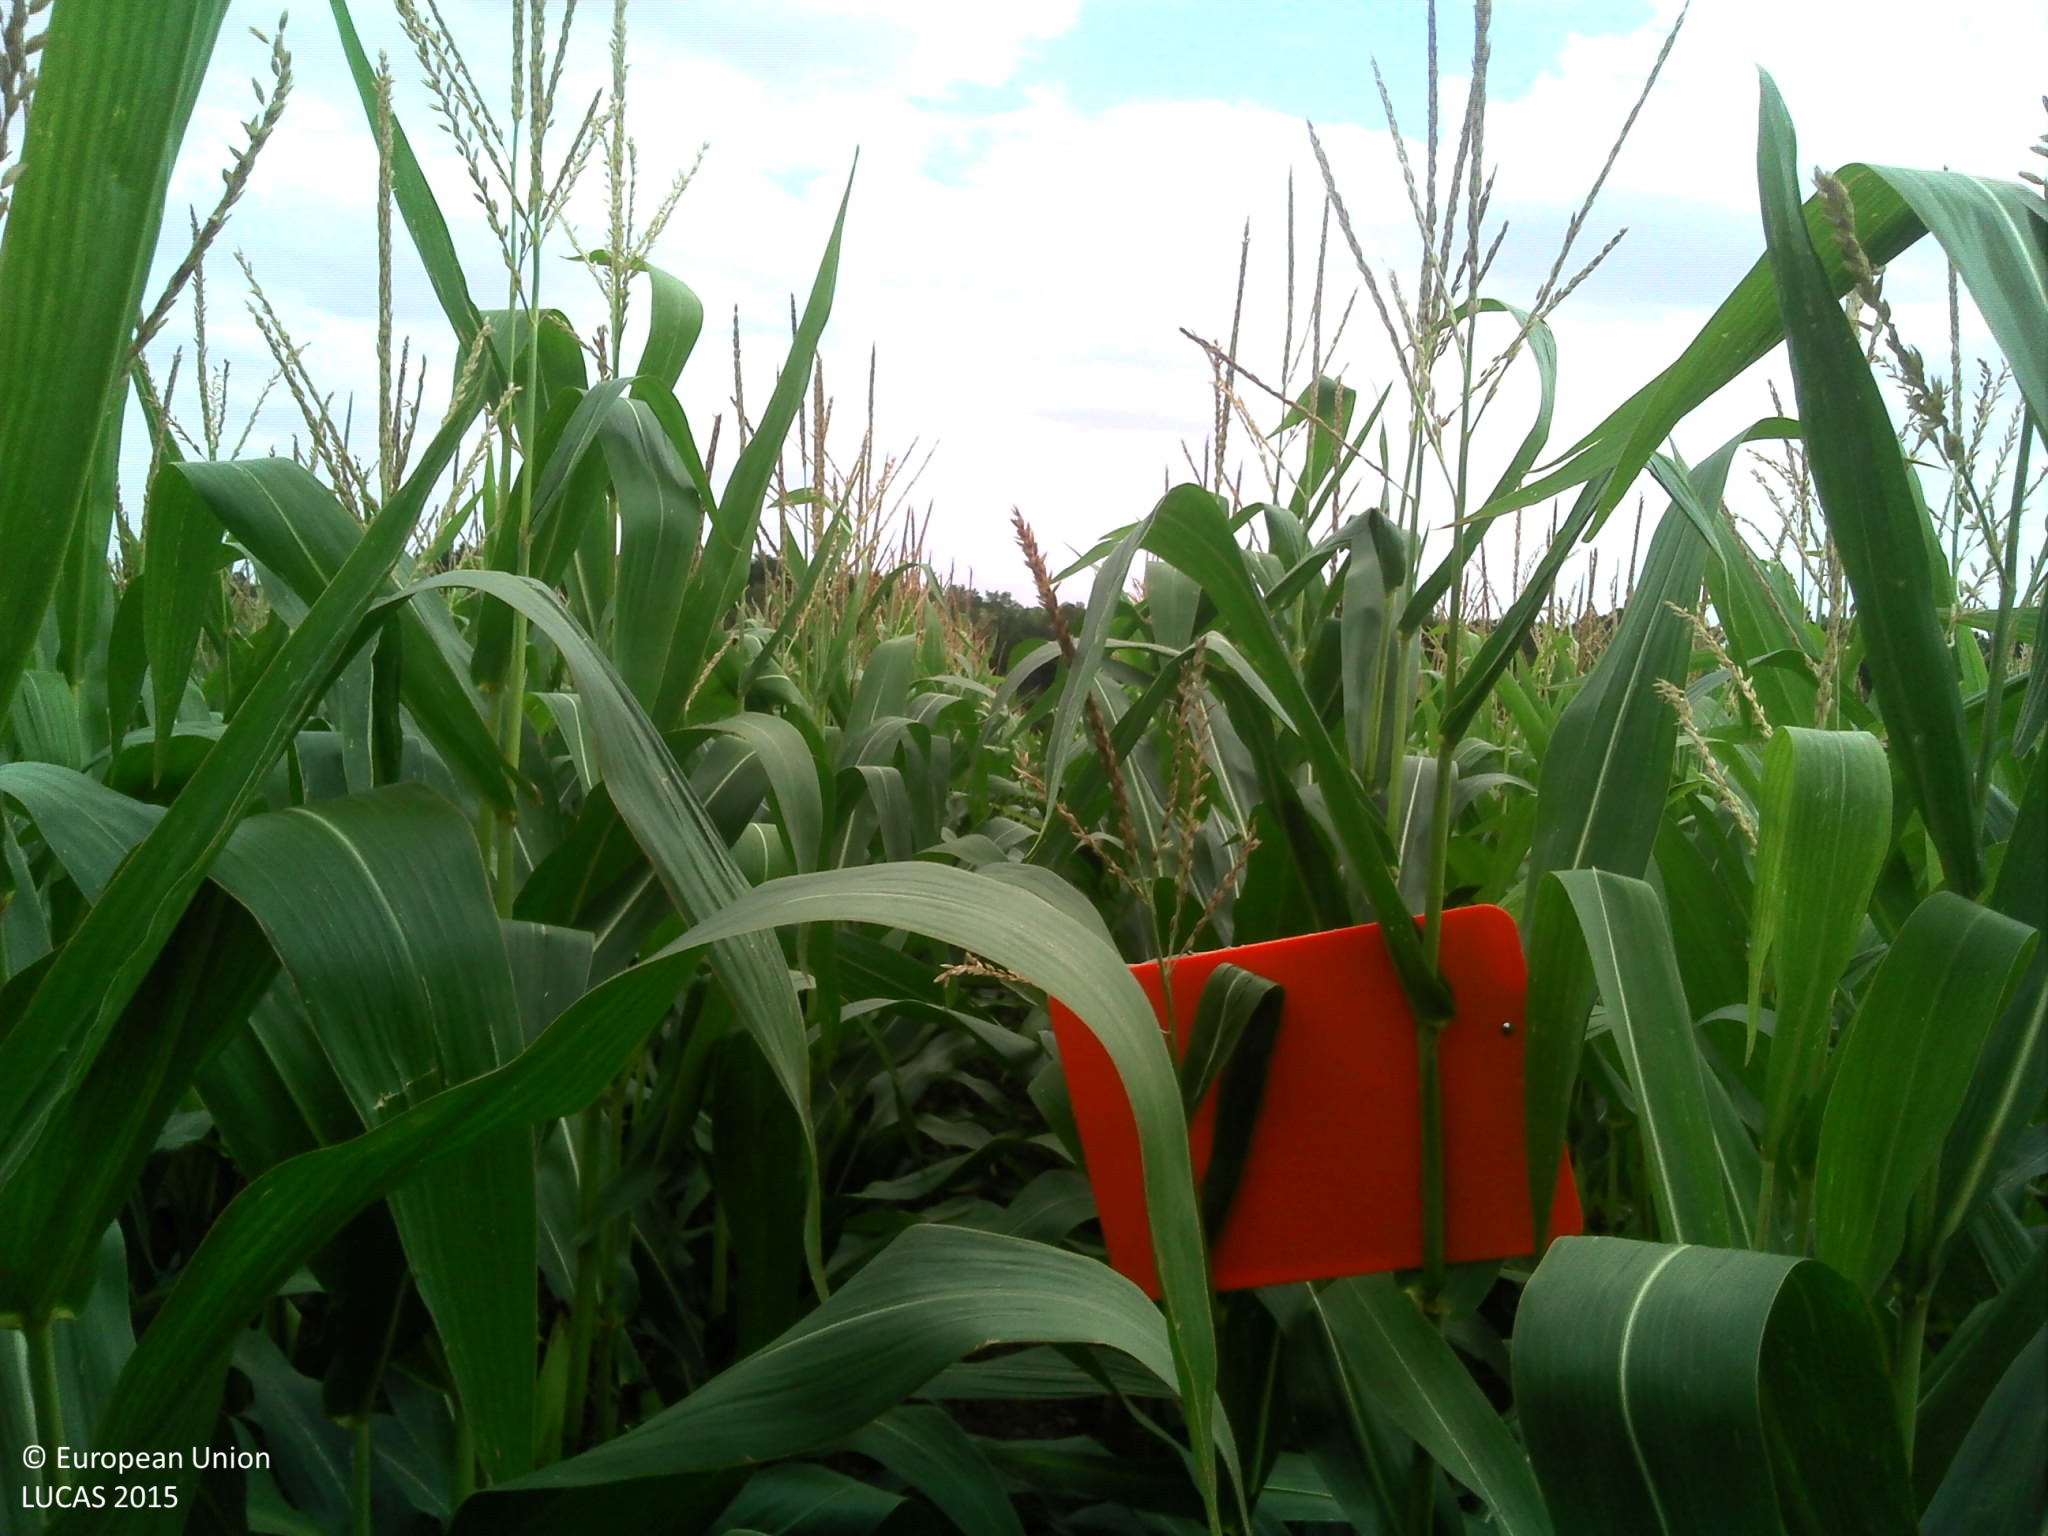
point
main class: Cropland
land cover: Maize
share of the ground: > 75 %
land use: Agriculture (excluding fallow land and kitchen gardens)
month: August
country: FR
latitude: 46.6234
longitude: -1.1217
